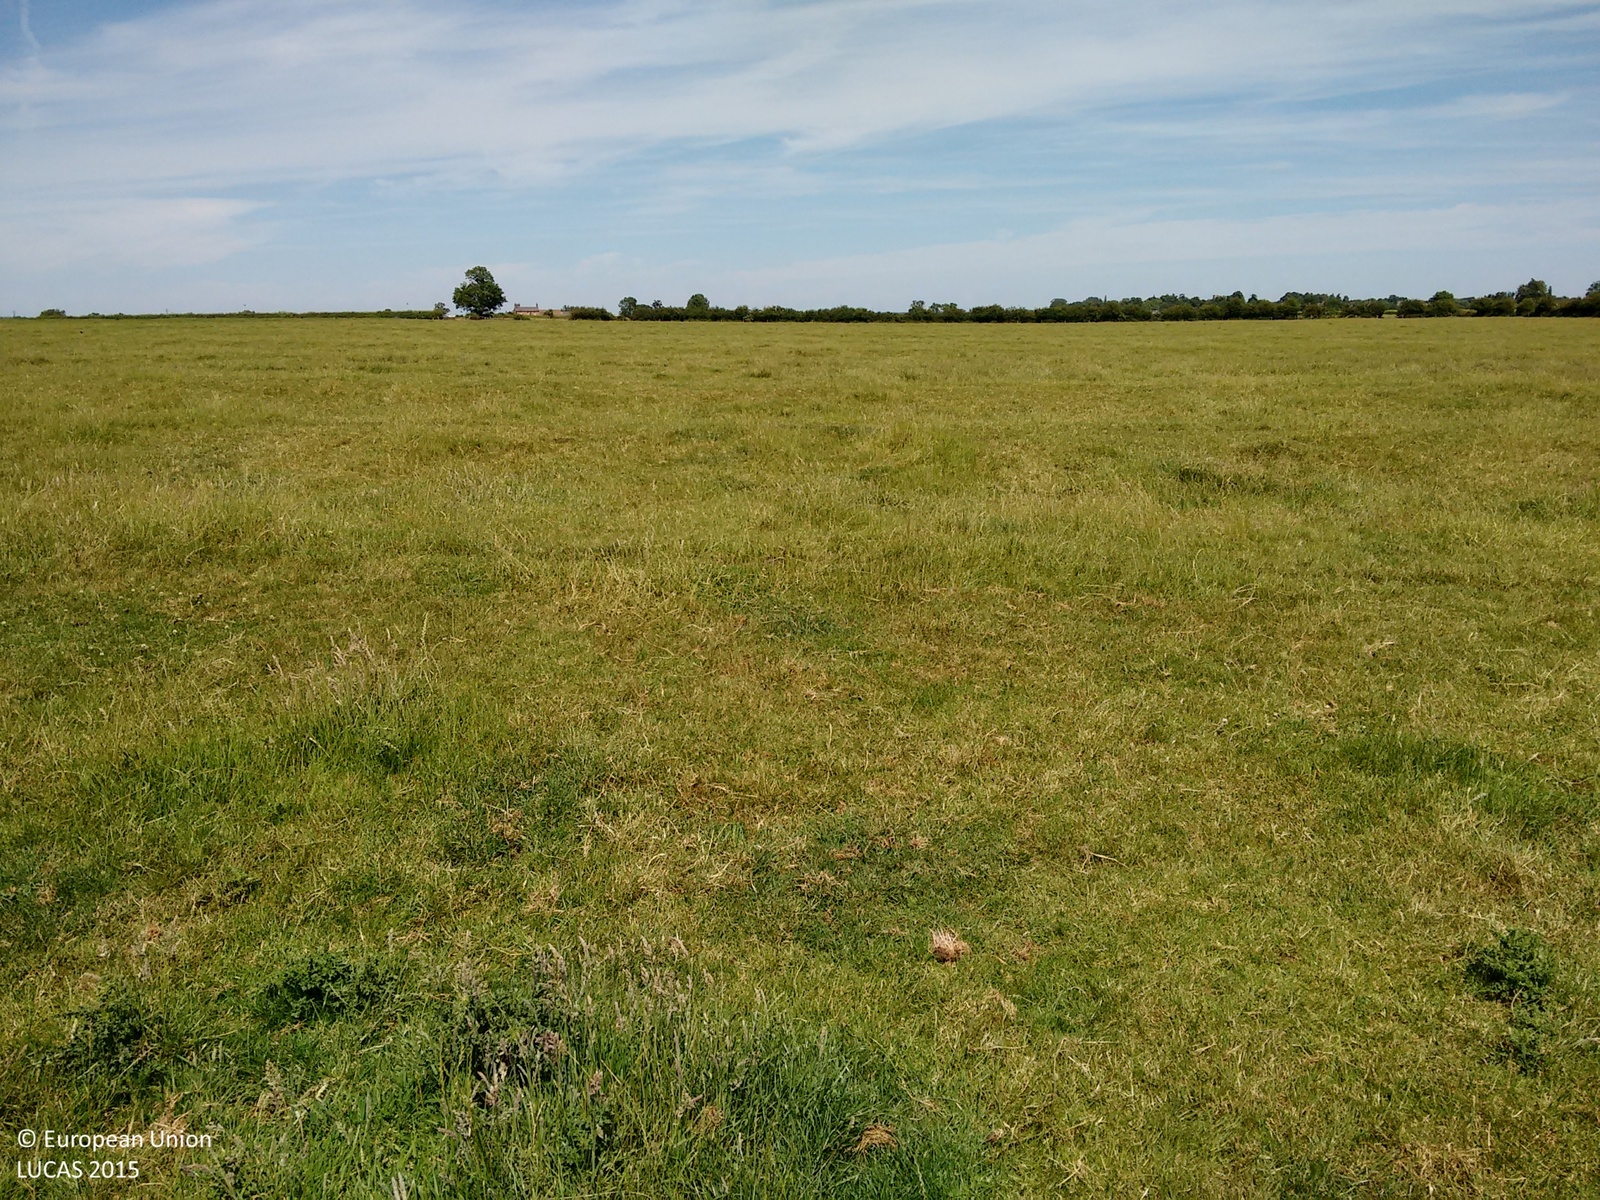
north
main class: Grassland
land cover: Grassland without tree/shrub cover
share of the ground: > 75 %
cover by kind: herbaceous plants 100 %
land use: Agriculture (excluding fallow land and kitchen gardens)
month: July
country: GB
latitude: 52.8868
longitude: -0.9368
